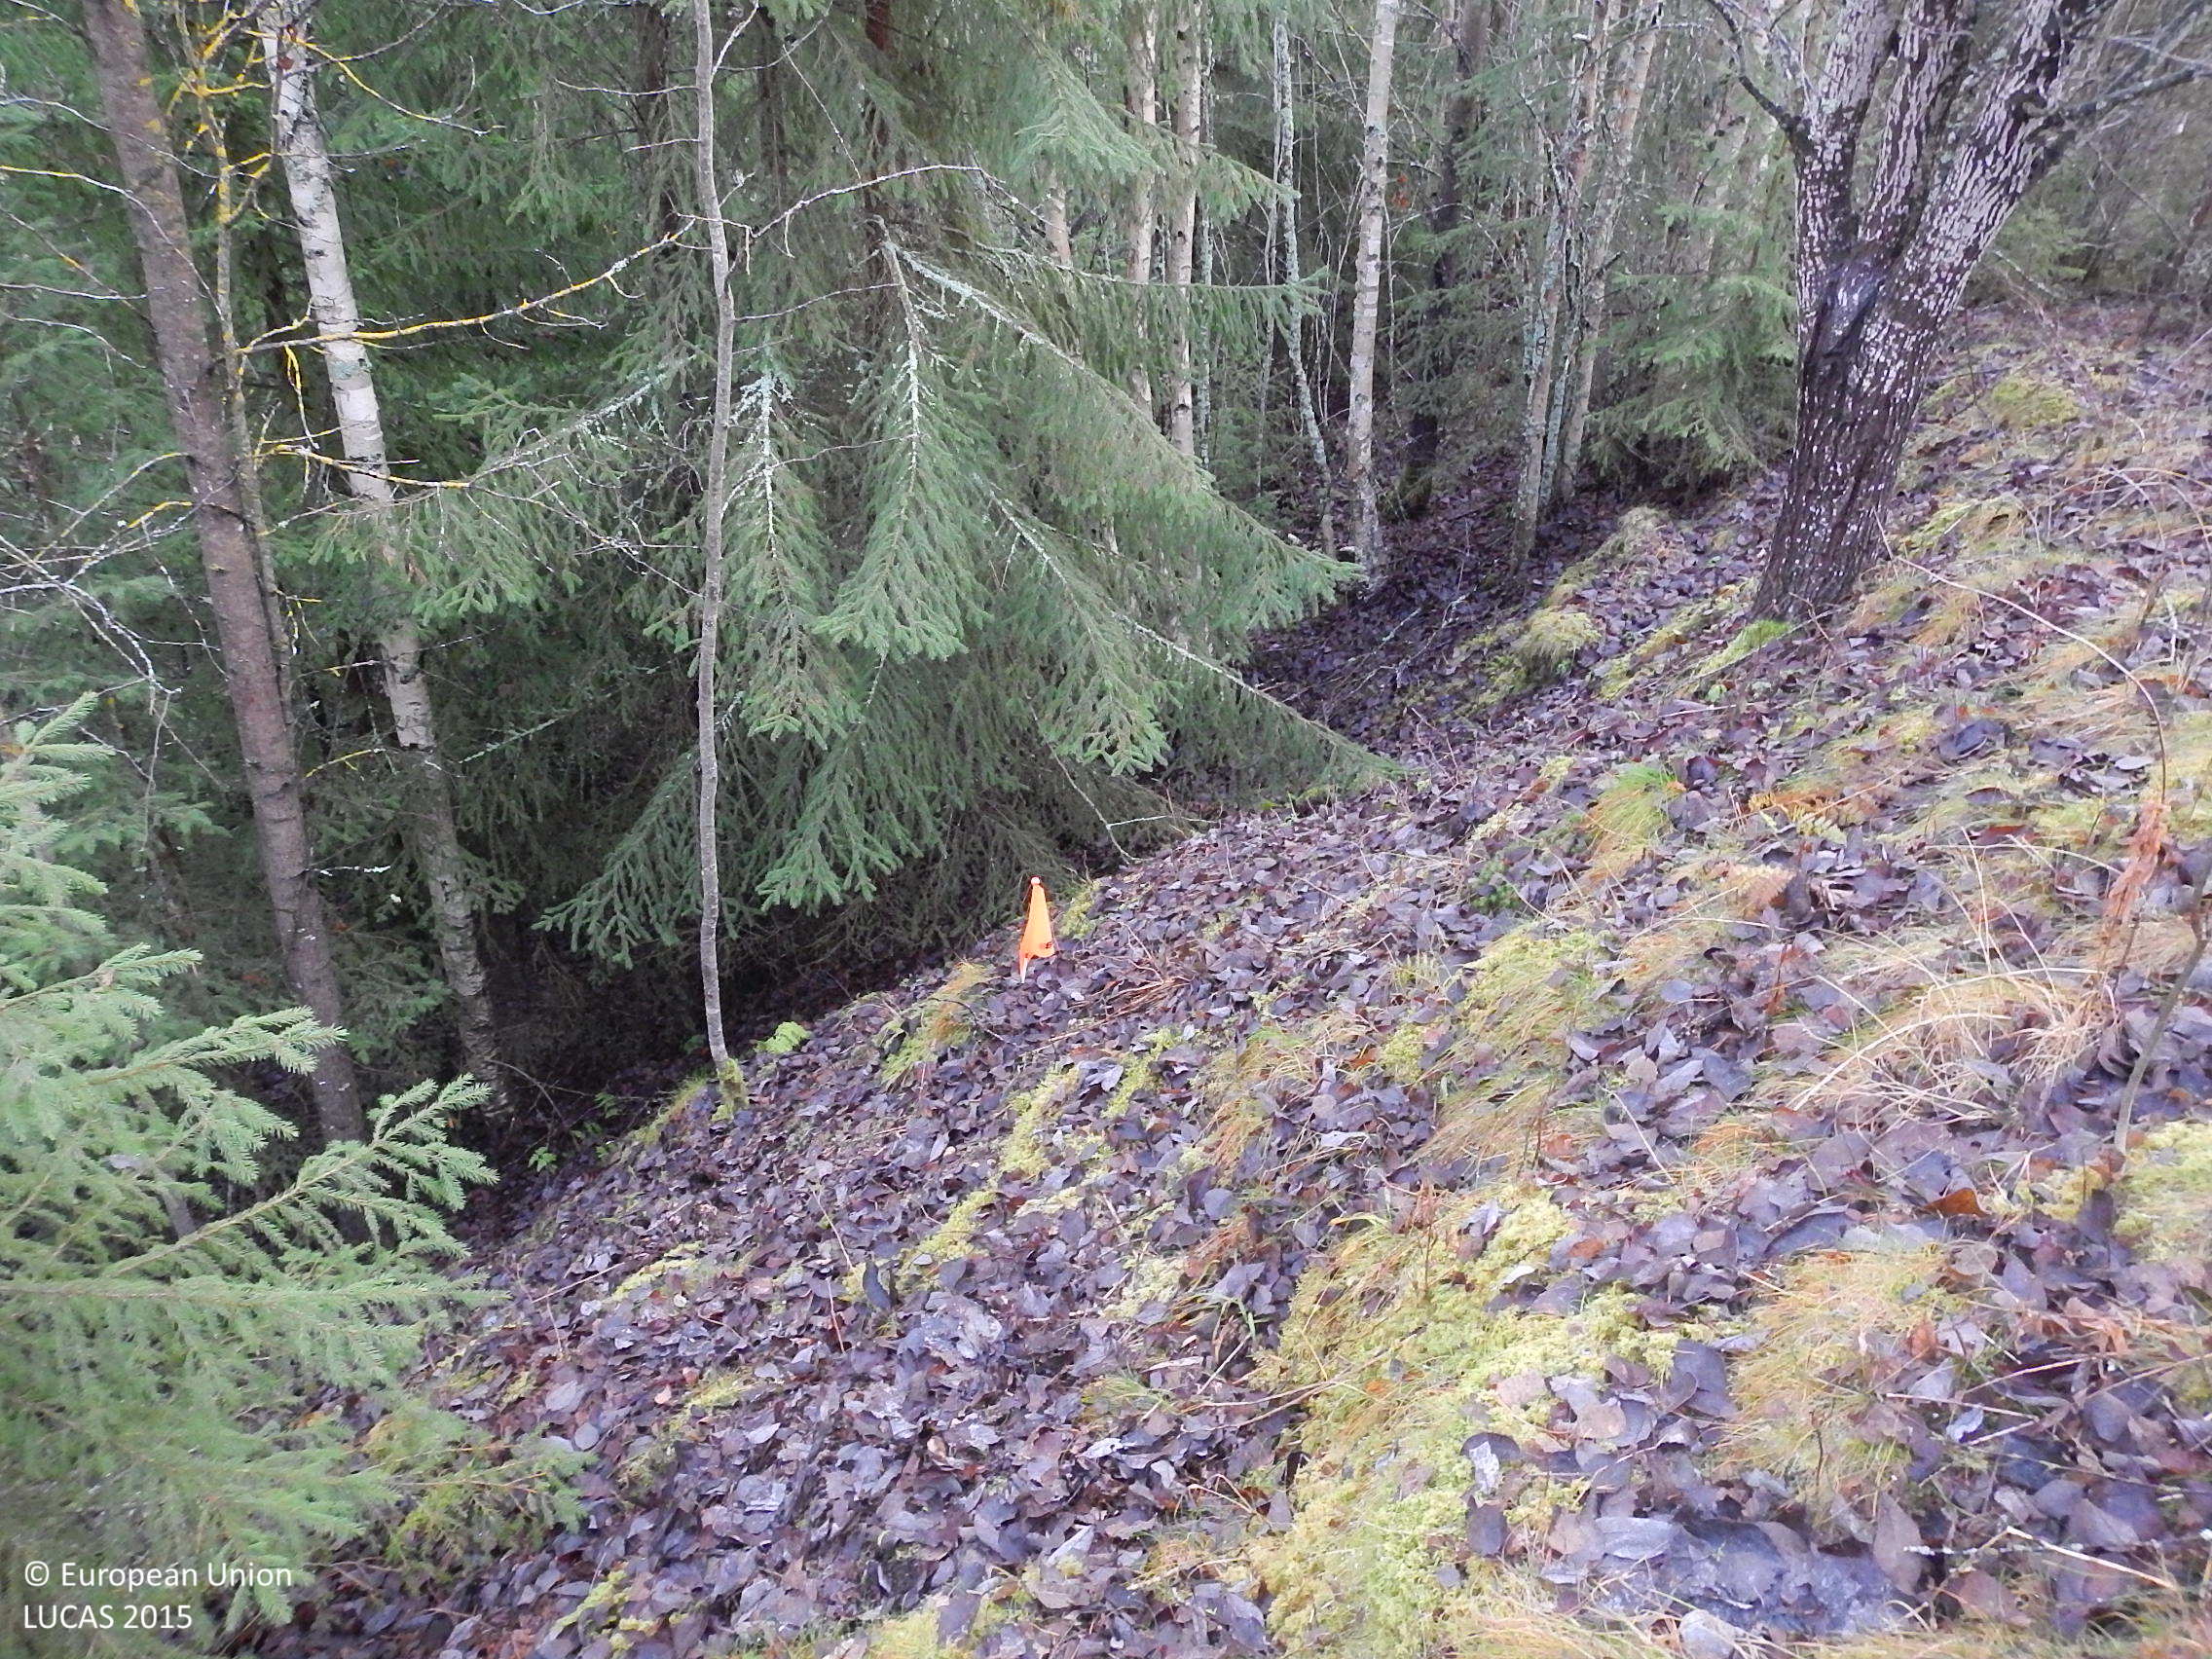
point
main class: Woodland
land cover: Spruce dominated mixed woodland
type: boreal forest
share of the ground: > 75 %
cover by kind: broadleaved forest trees 60 %, coniferous forest trees 20 %, herbaceous plants 10 %, lichens and mosses 5 %
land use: Forestry
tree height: > 5 m
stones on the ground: < 10 %
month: November
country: SE
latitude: 61.7668
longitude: 16.0654
